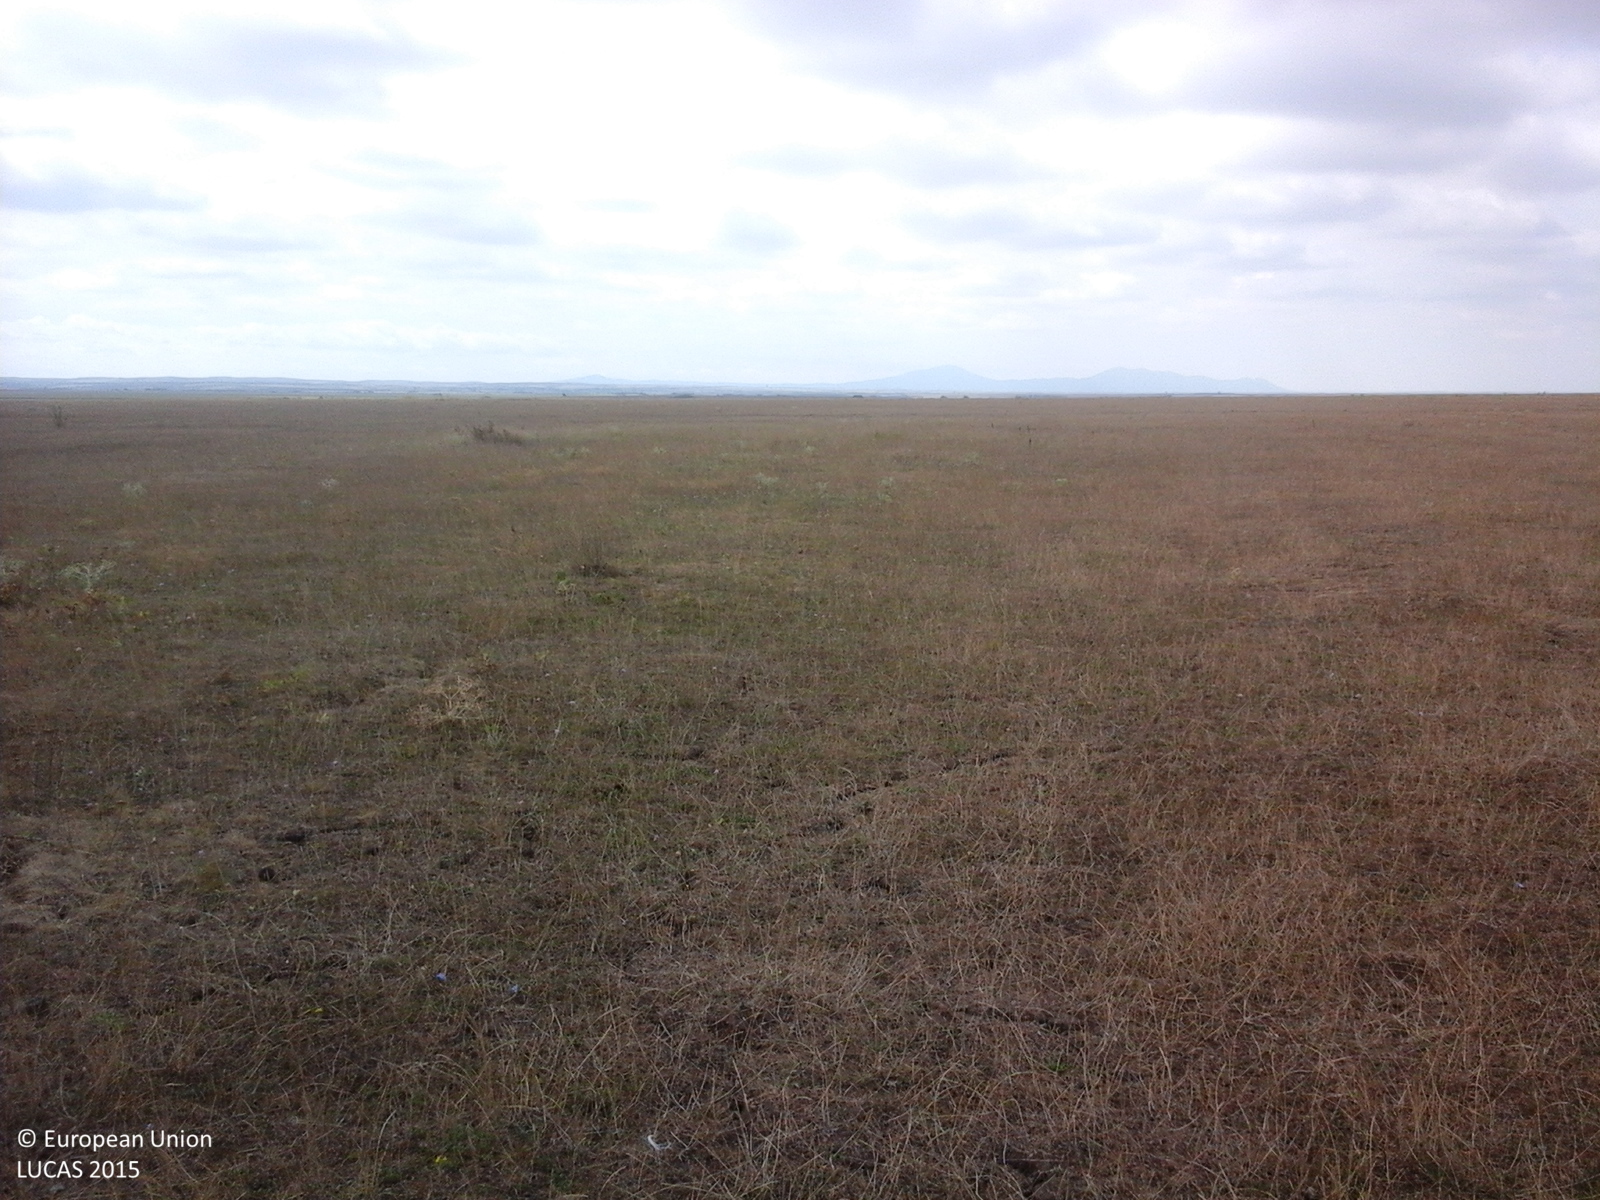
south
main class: Grassland
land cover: Grassland without tree/shrub cover
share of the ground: > 75 %
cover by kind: herbaceous plants 100 %
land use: Agriculture (excluding fallow land and kitchen gardens)
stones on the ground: < 10 %
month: August
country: RO
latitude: 45.4023
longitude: 21.4913
